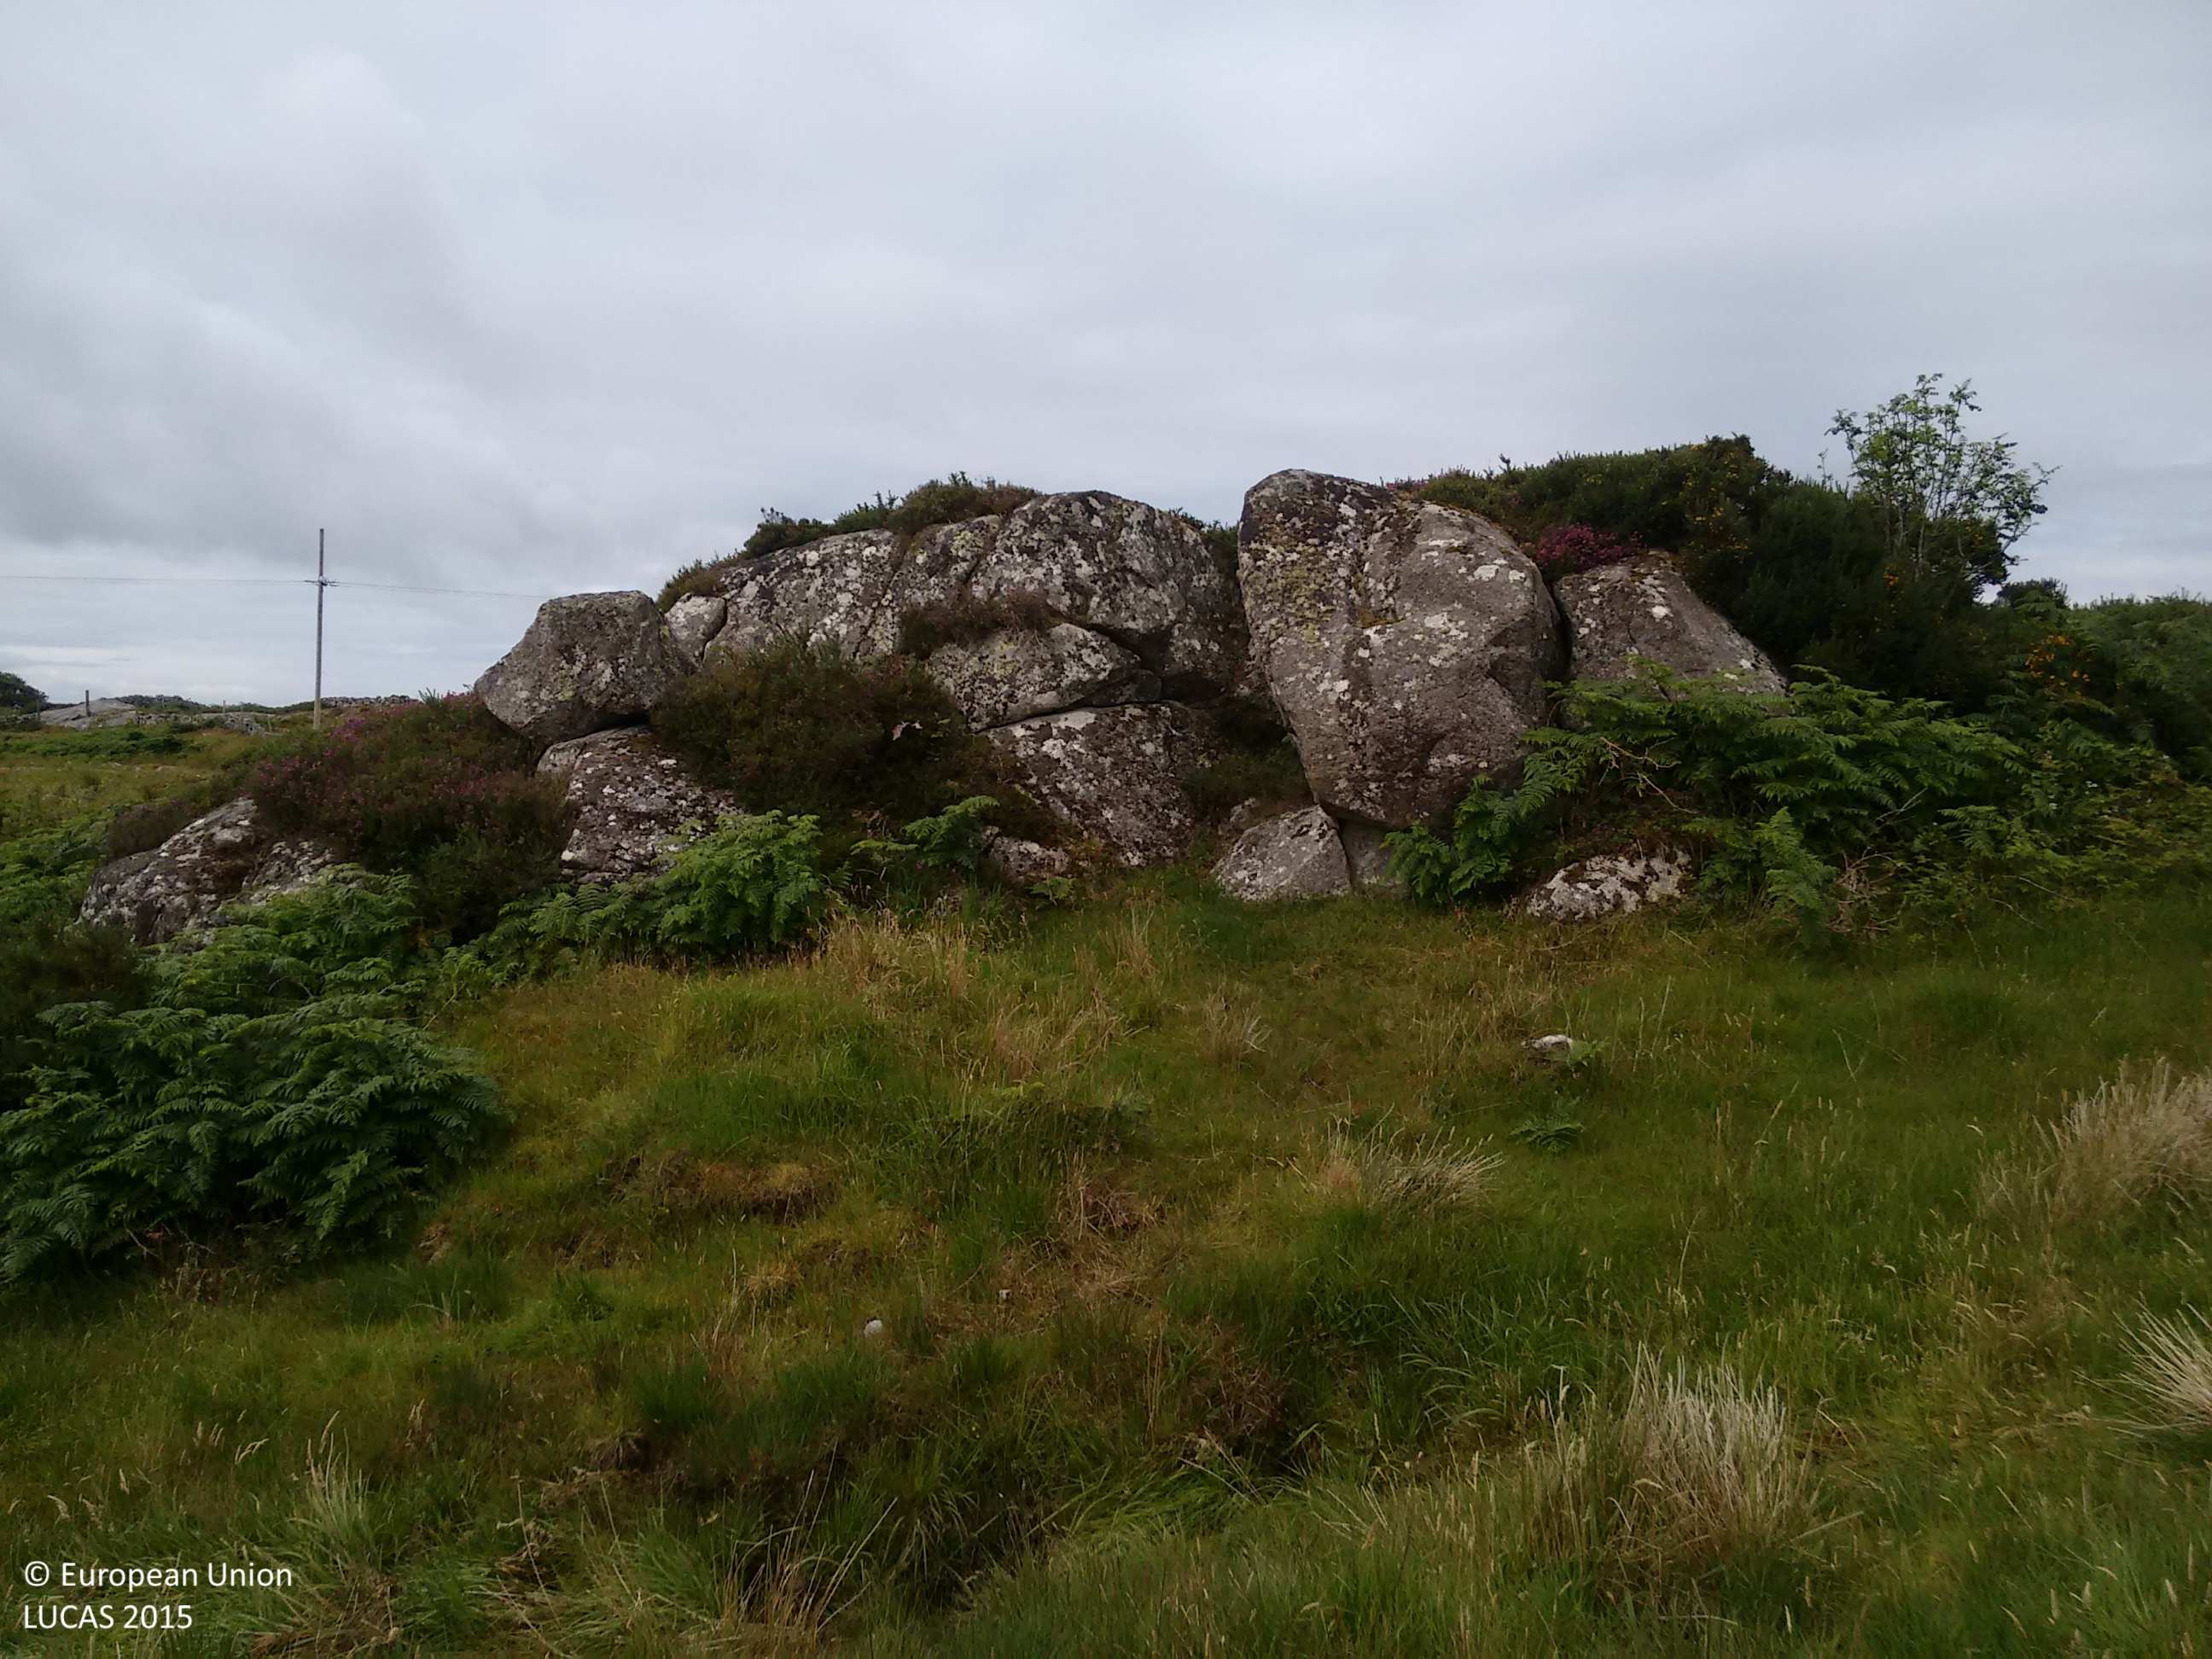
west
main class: Grassland
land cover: Grassland with sparse tree/shrub cover
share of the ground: 50 - 75 %
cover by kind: herbaceous plants 85 %, shrubs 10 %, broadleaved forest trees 5 %
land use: Agriculture (excluding fallow land and kitchen gardens)
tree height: < 5 m
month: July
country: IE
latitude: 53.2879
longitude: -9.5403
